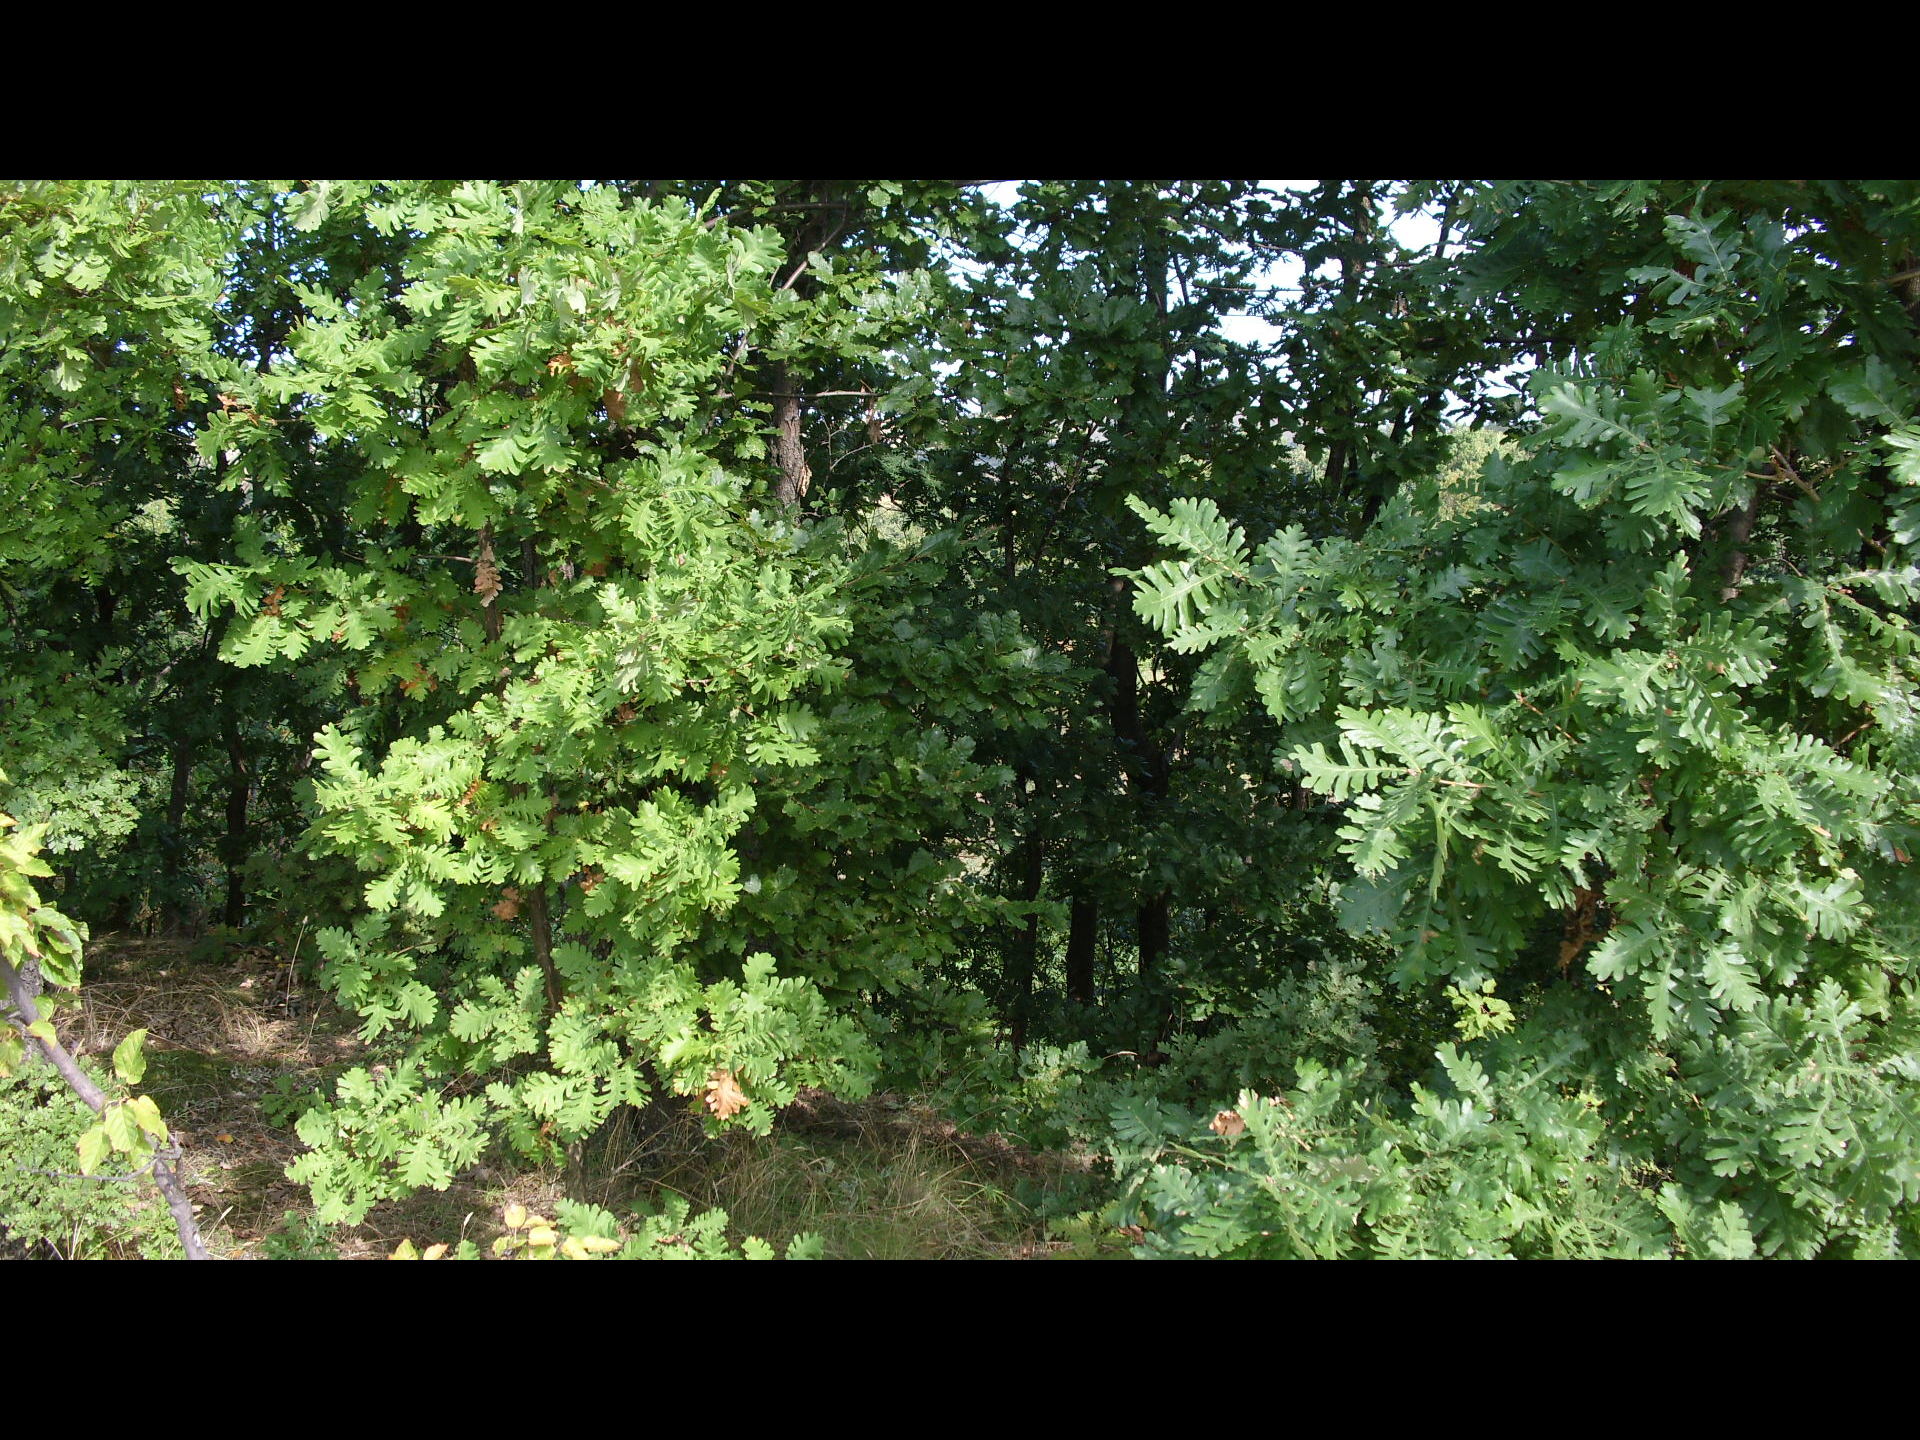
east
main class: Woodland
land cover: Broadleaved woodland
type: mesophytic deciduous forest
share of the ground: 50 - 75 %
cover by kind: broadleaved forest trees 55 %, herbaceous plants 25 %, shrubs 20 %
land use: Forestry
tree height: > 5 m
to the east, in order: Broadleaved woodland; Rivers and streams; Broadleaved woodland; Shrubland with sparse tree cover; Potatoes; Grass margins; Potatoes; Grass margins; Potatoes; Grassland without tree/shrub cover; Tracks; Shrubland without tree cover; Spontaneously vegetated surfaces; Shrubland without tree cover; Broadleaved woodland
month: August
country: BG
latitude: 43.5152
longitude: 22.9641
